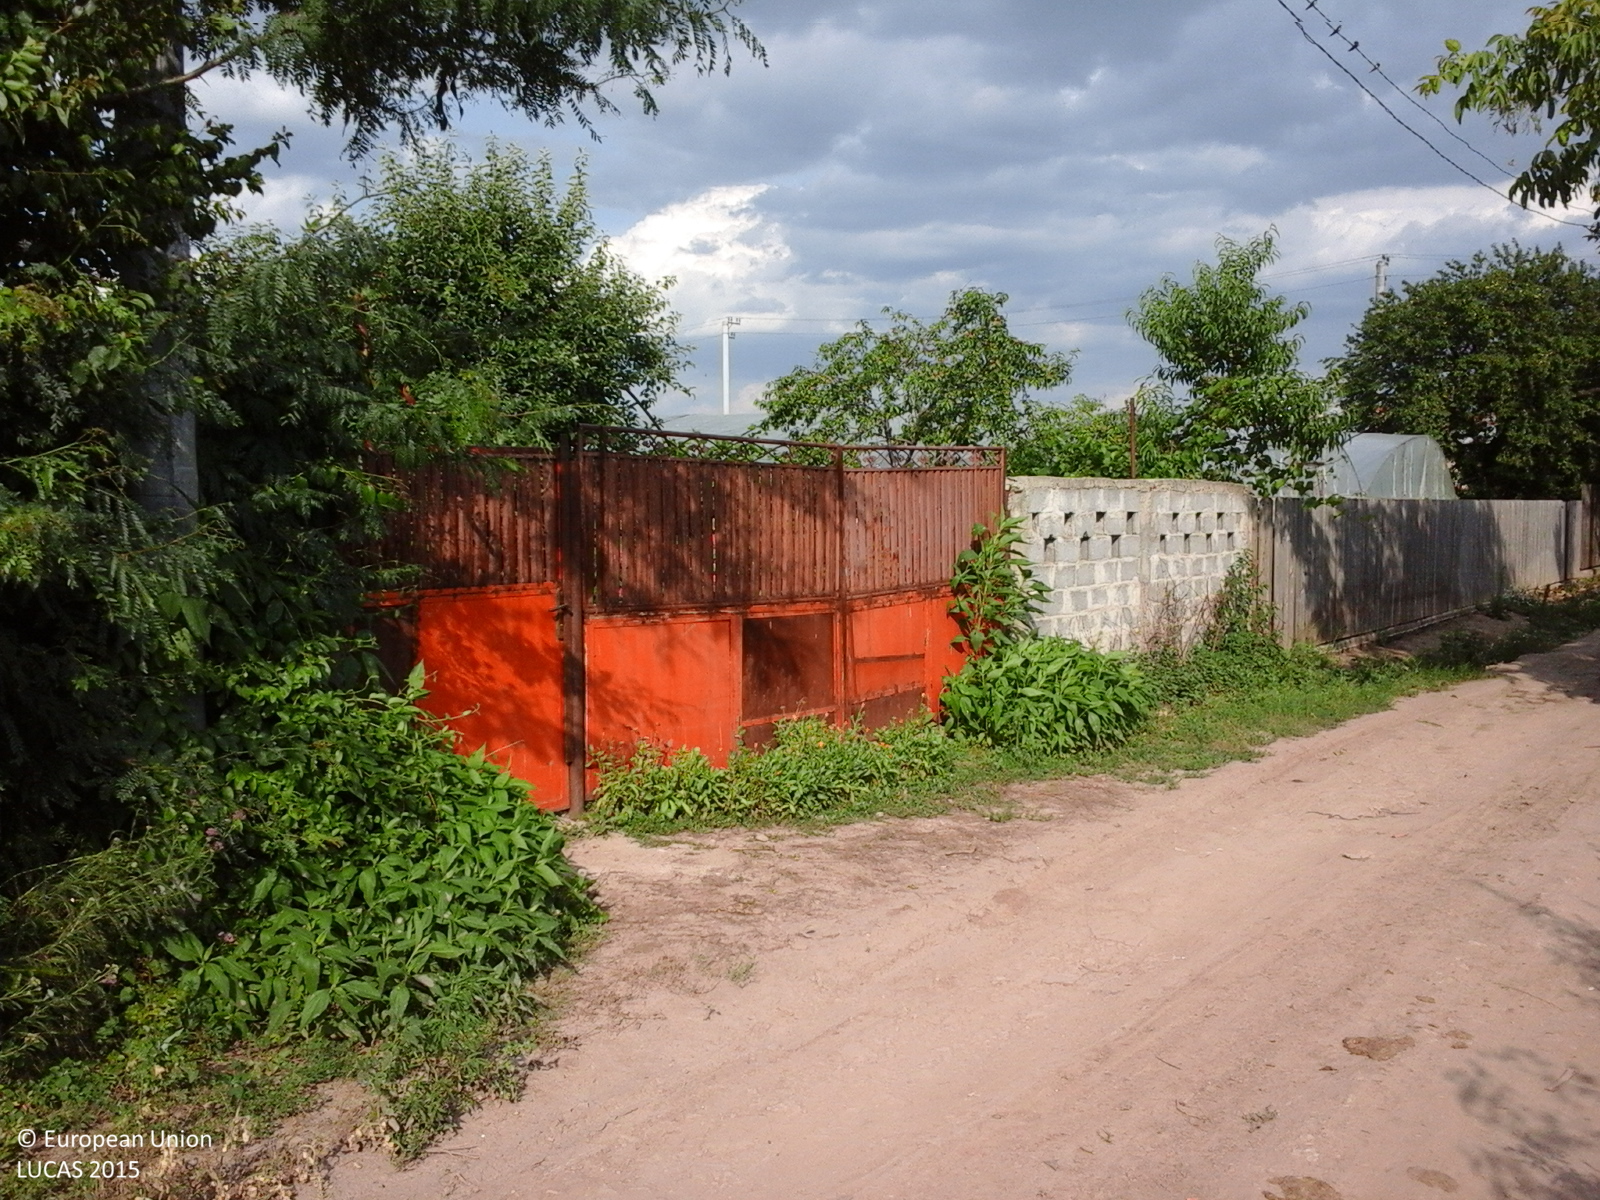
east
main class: Cropland
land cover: Maize
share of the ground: > 75 %
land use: Agriculture (excluding fallow land and kitchen gardens)
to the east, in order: Maize; Artificial constructions in urban areas; Lucerne; Spontaneously vegetated surfaces; Tracks; Spontaneously vegetated surfaces; Tracks; Common wheat
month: June
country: RO
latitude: 44.3116
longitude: 26.1134
